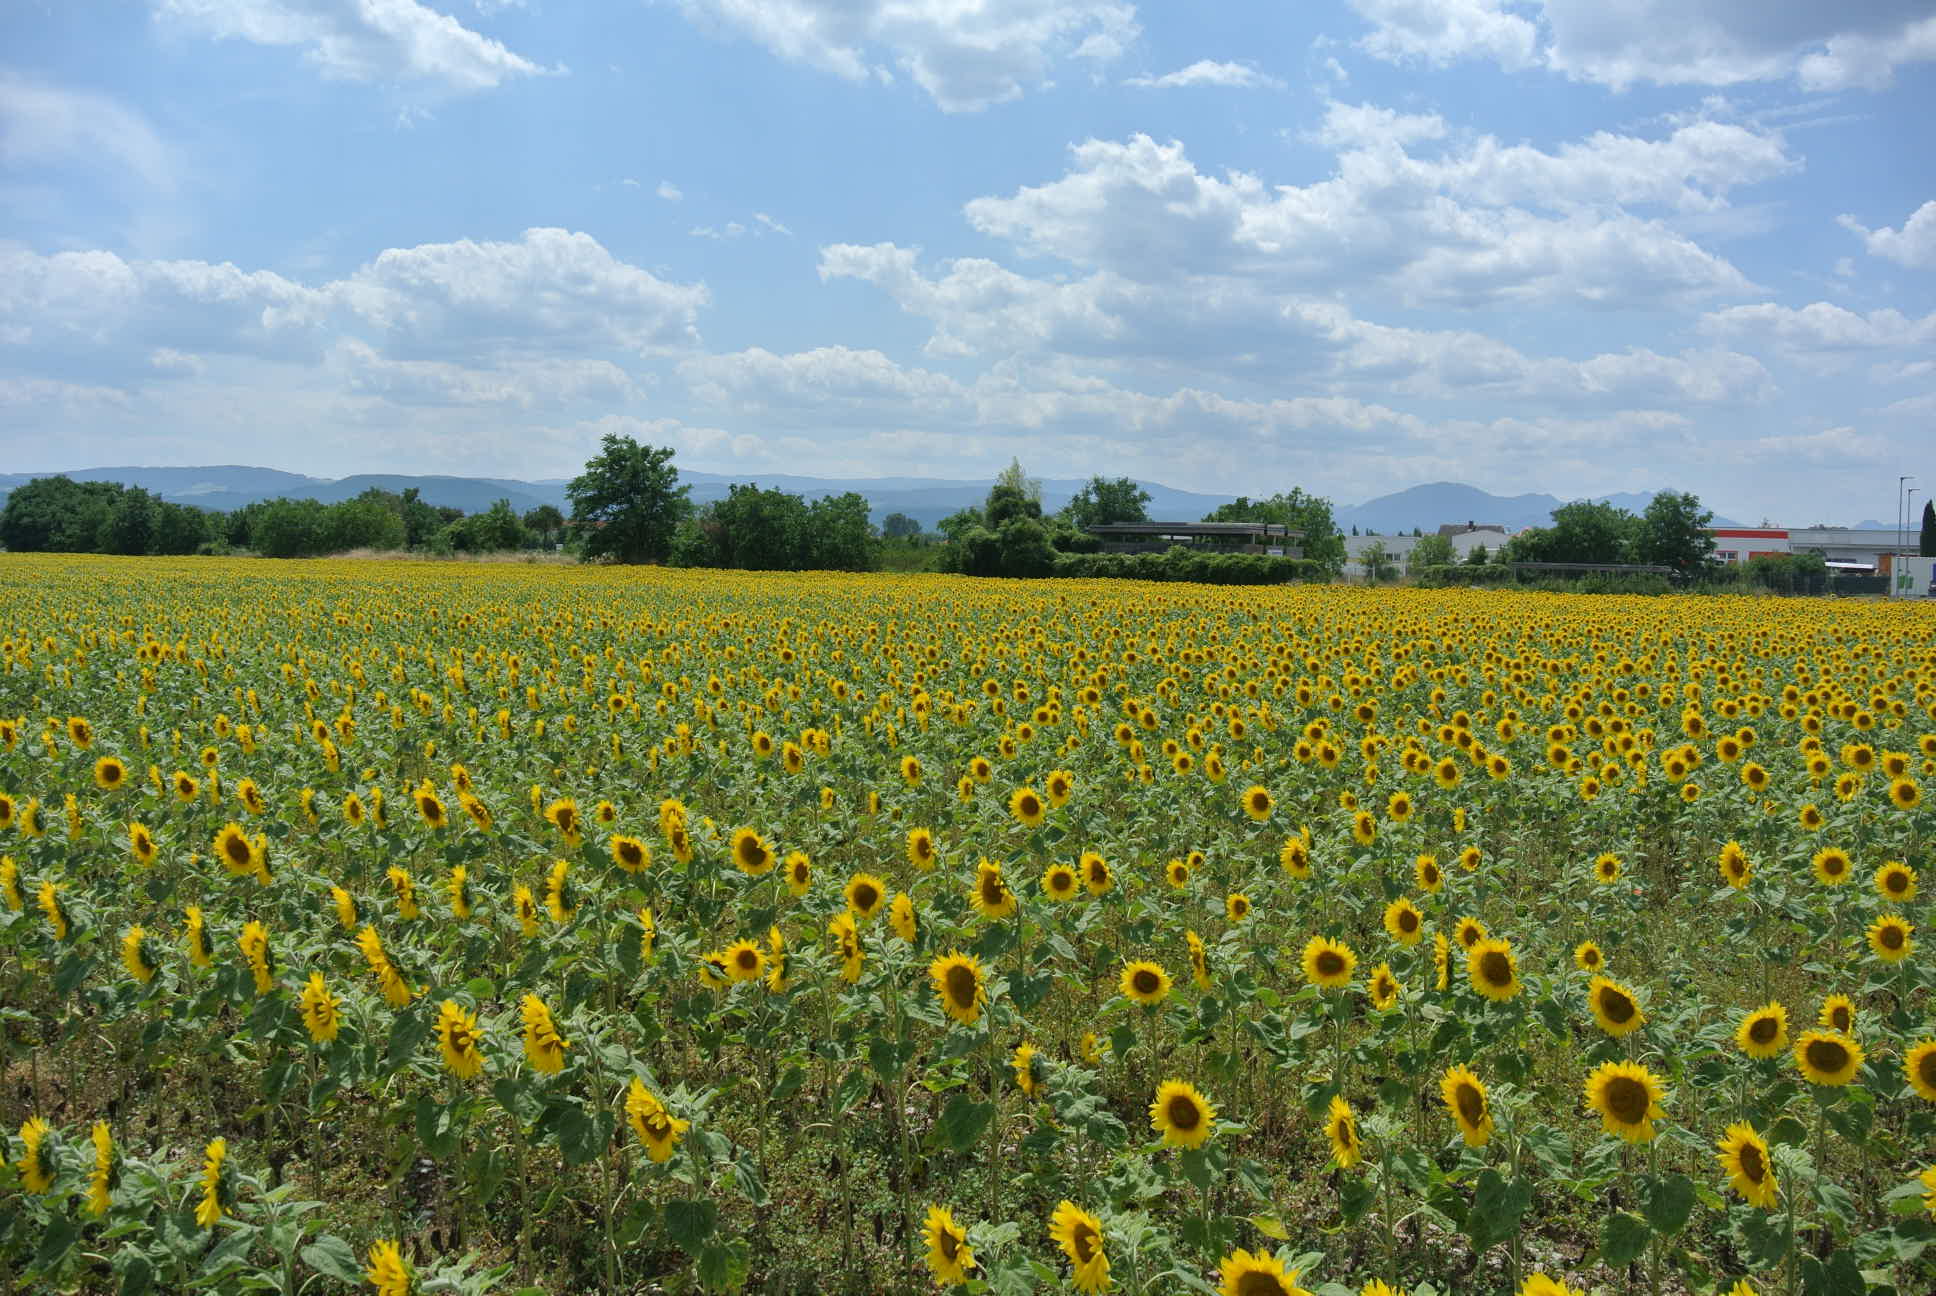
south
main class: Cropland
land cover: Sunflower
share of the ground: > 75 %
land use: Agriculture (excluding fallow land and kitchen gardens)
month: July
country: AT
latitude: 47.7300
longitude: 16.0964
